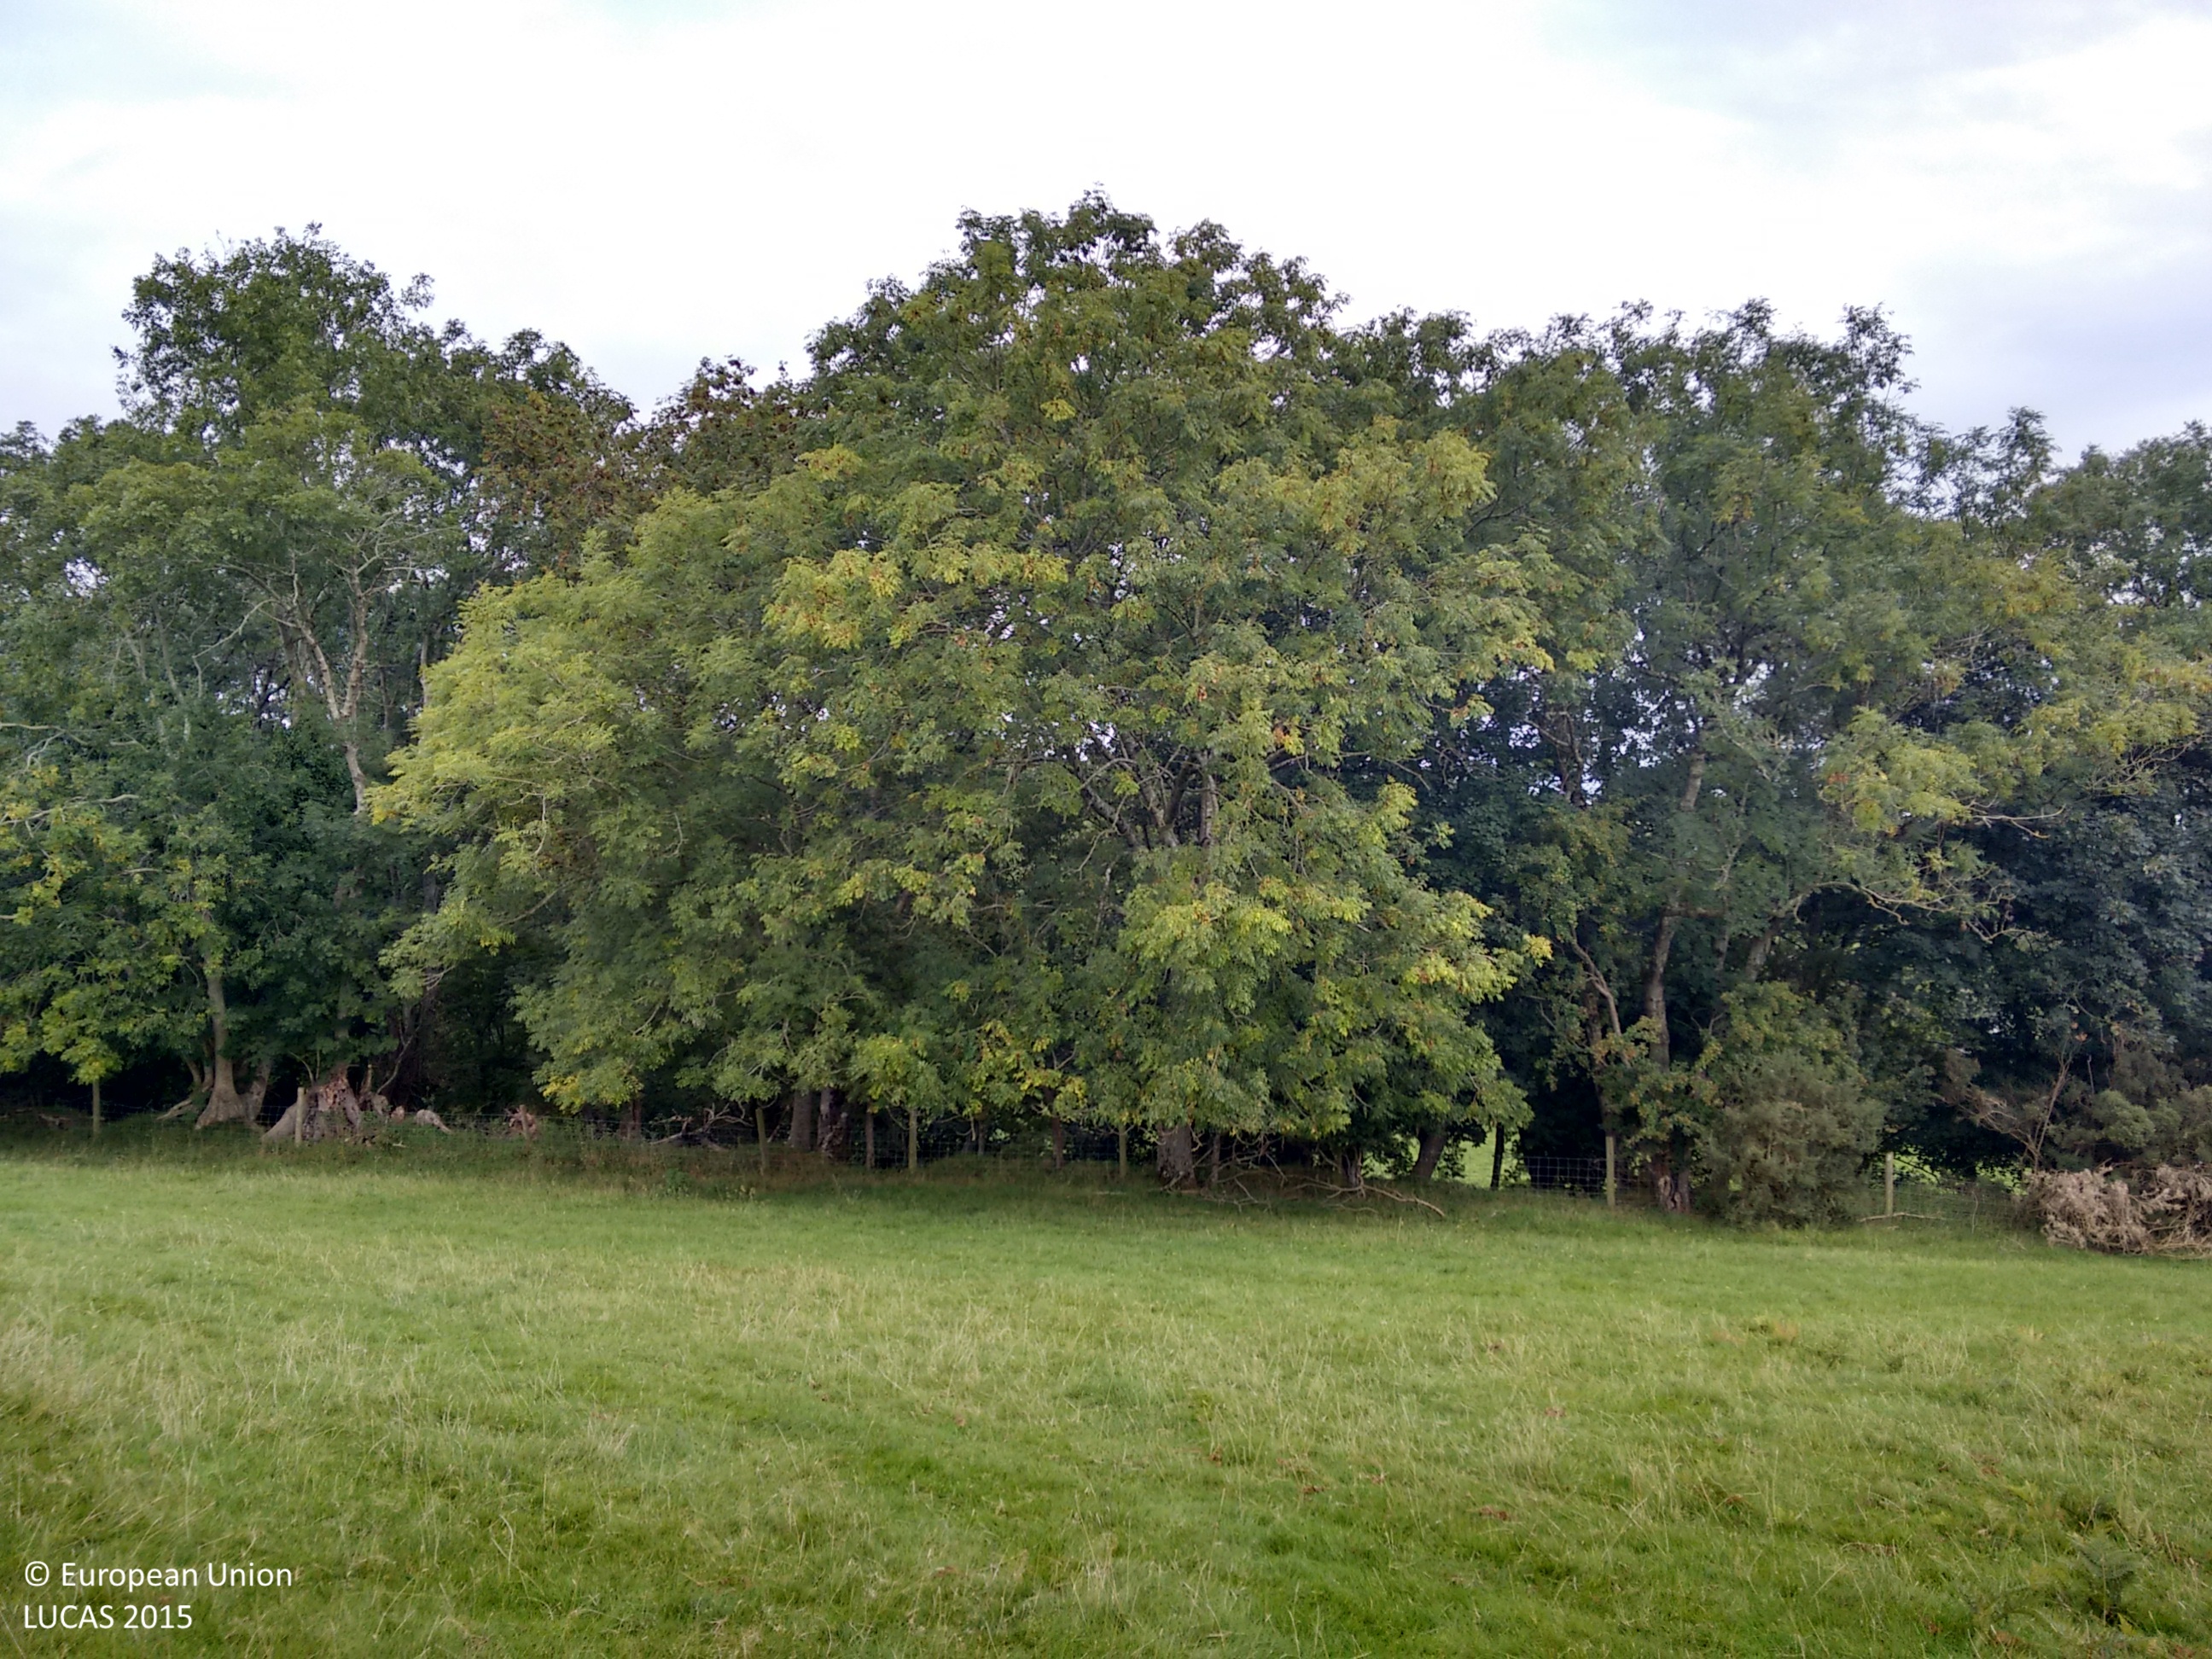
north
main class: Grassland
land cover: Grassland without tree/shrub cover
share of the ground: > 75 %
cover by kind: herbaceous plants 100 %
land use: Agriculture (excluding fallow land and kitchen gardens)
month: September
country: GB
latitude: 52.1320
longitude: -4.5549
